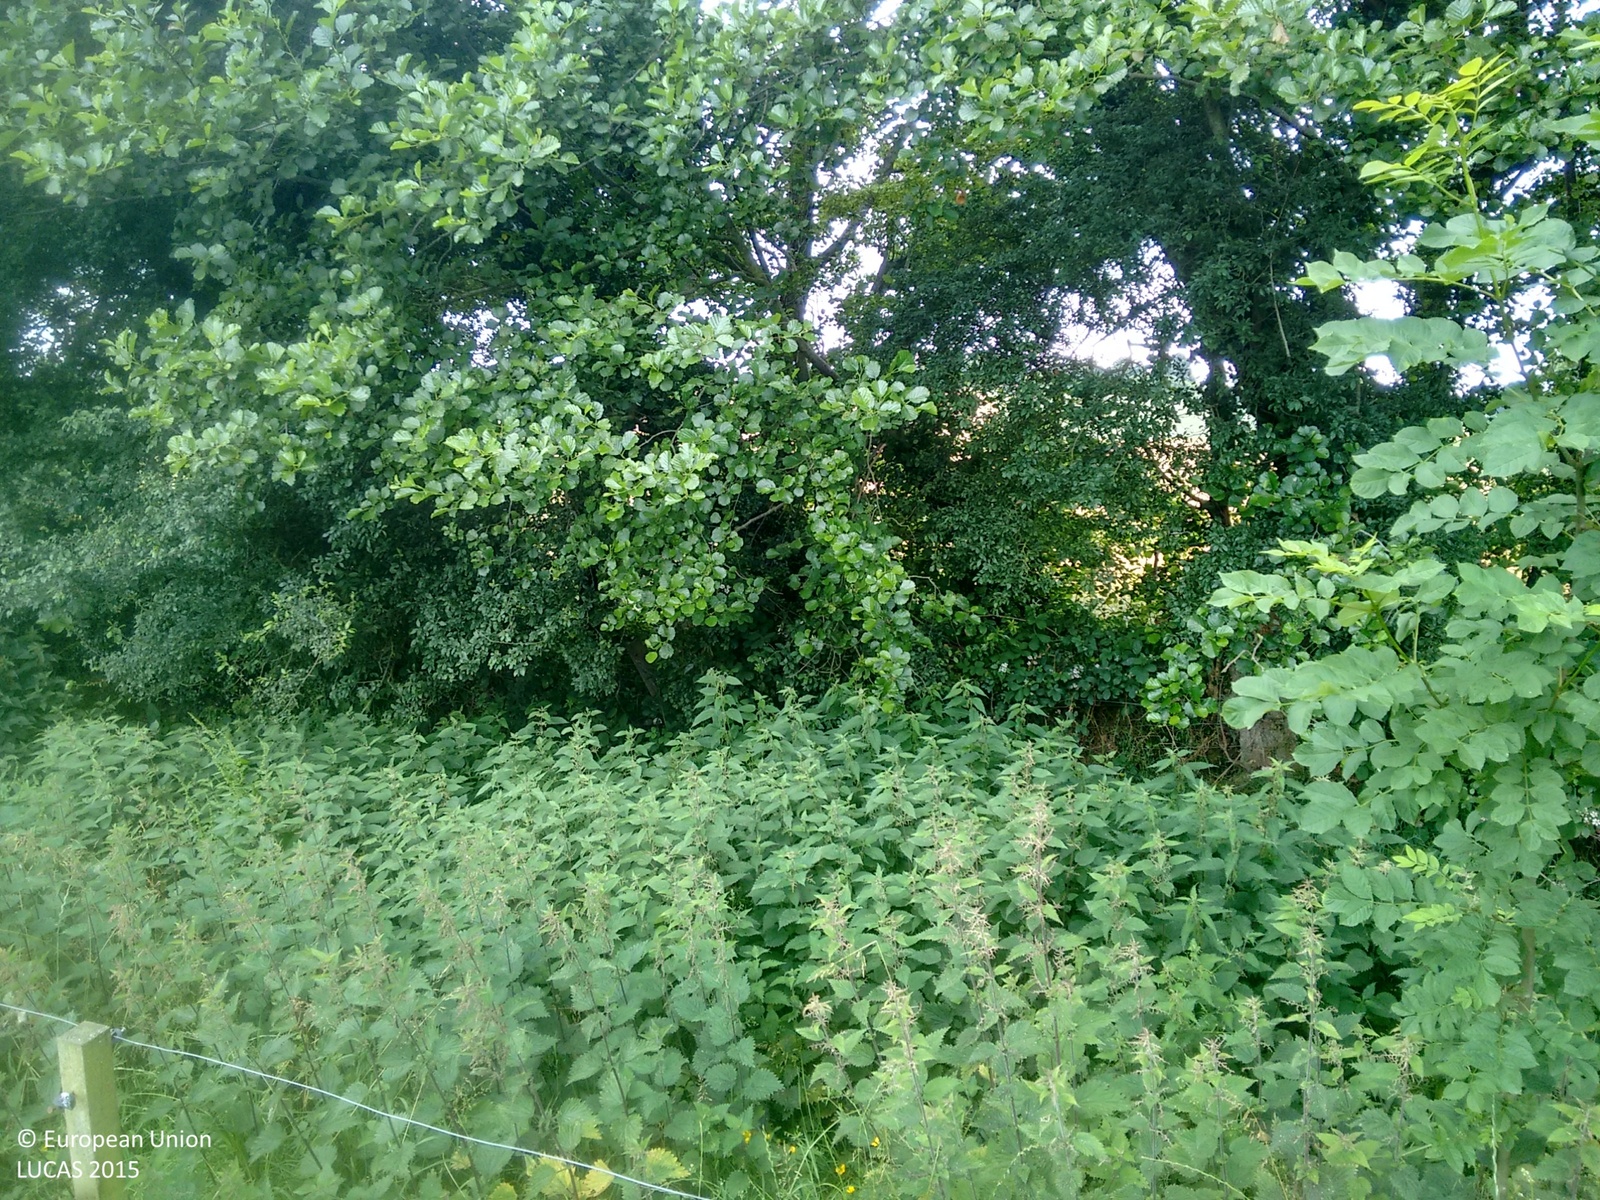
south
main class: Grassland
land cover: Grassland without tree/shrub cover
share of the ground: > 75 %
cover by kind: herbaceous plants 100 %
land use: Agriculture (excluding fallow land and kitchen gardens)
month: July
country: IE
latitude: 52.7691
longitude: -6.6583
